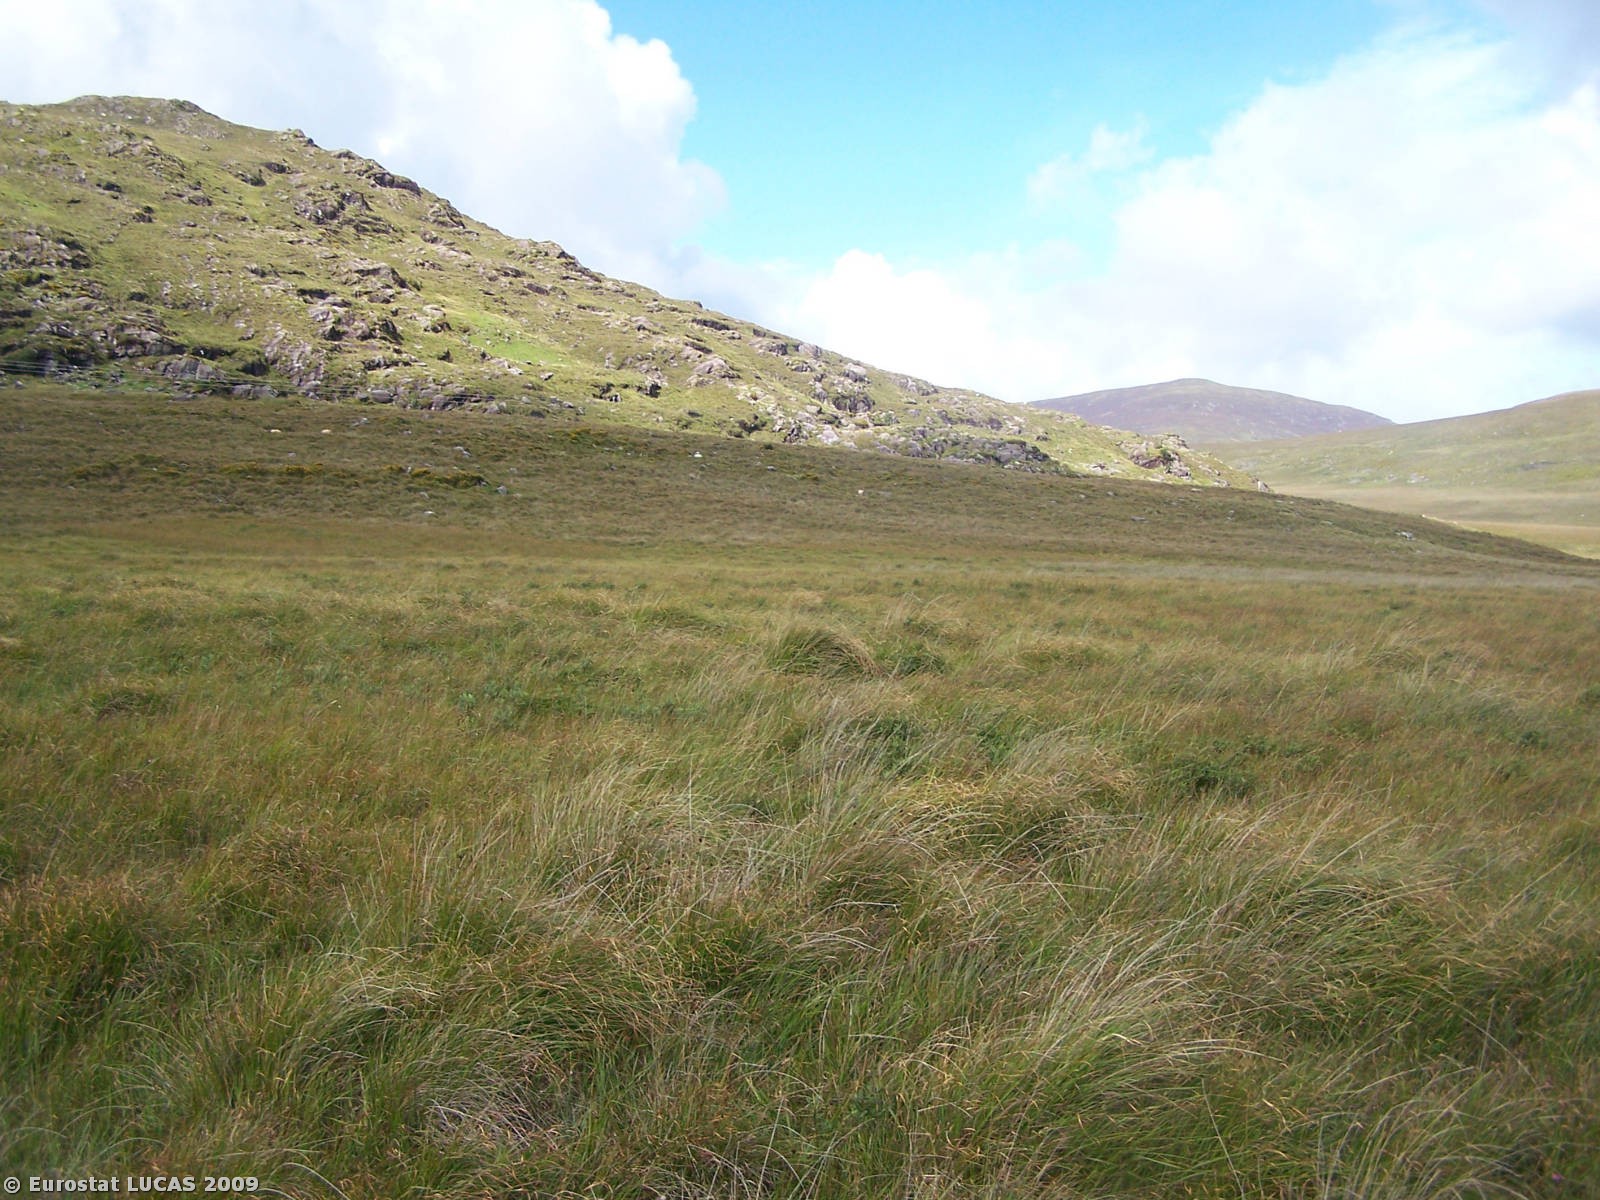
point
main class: Wetlands
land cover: Peatbogs
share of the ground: > 75 %
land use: Mining and quarrying
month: September
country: IE
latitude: 51.9631
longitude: -9.9125
